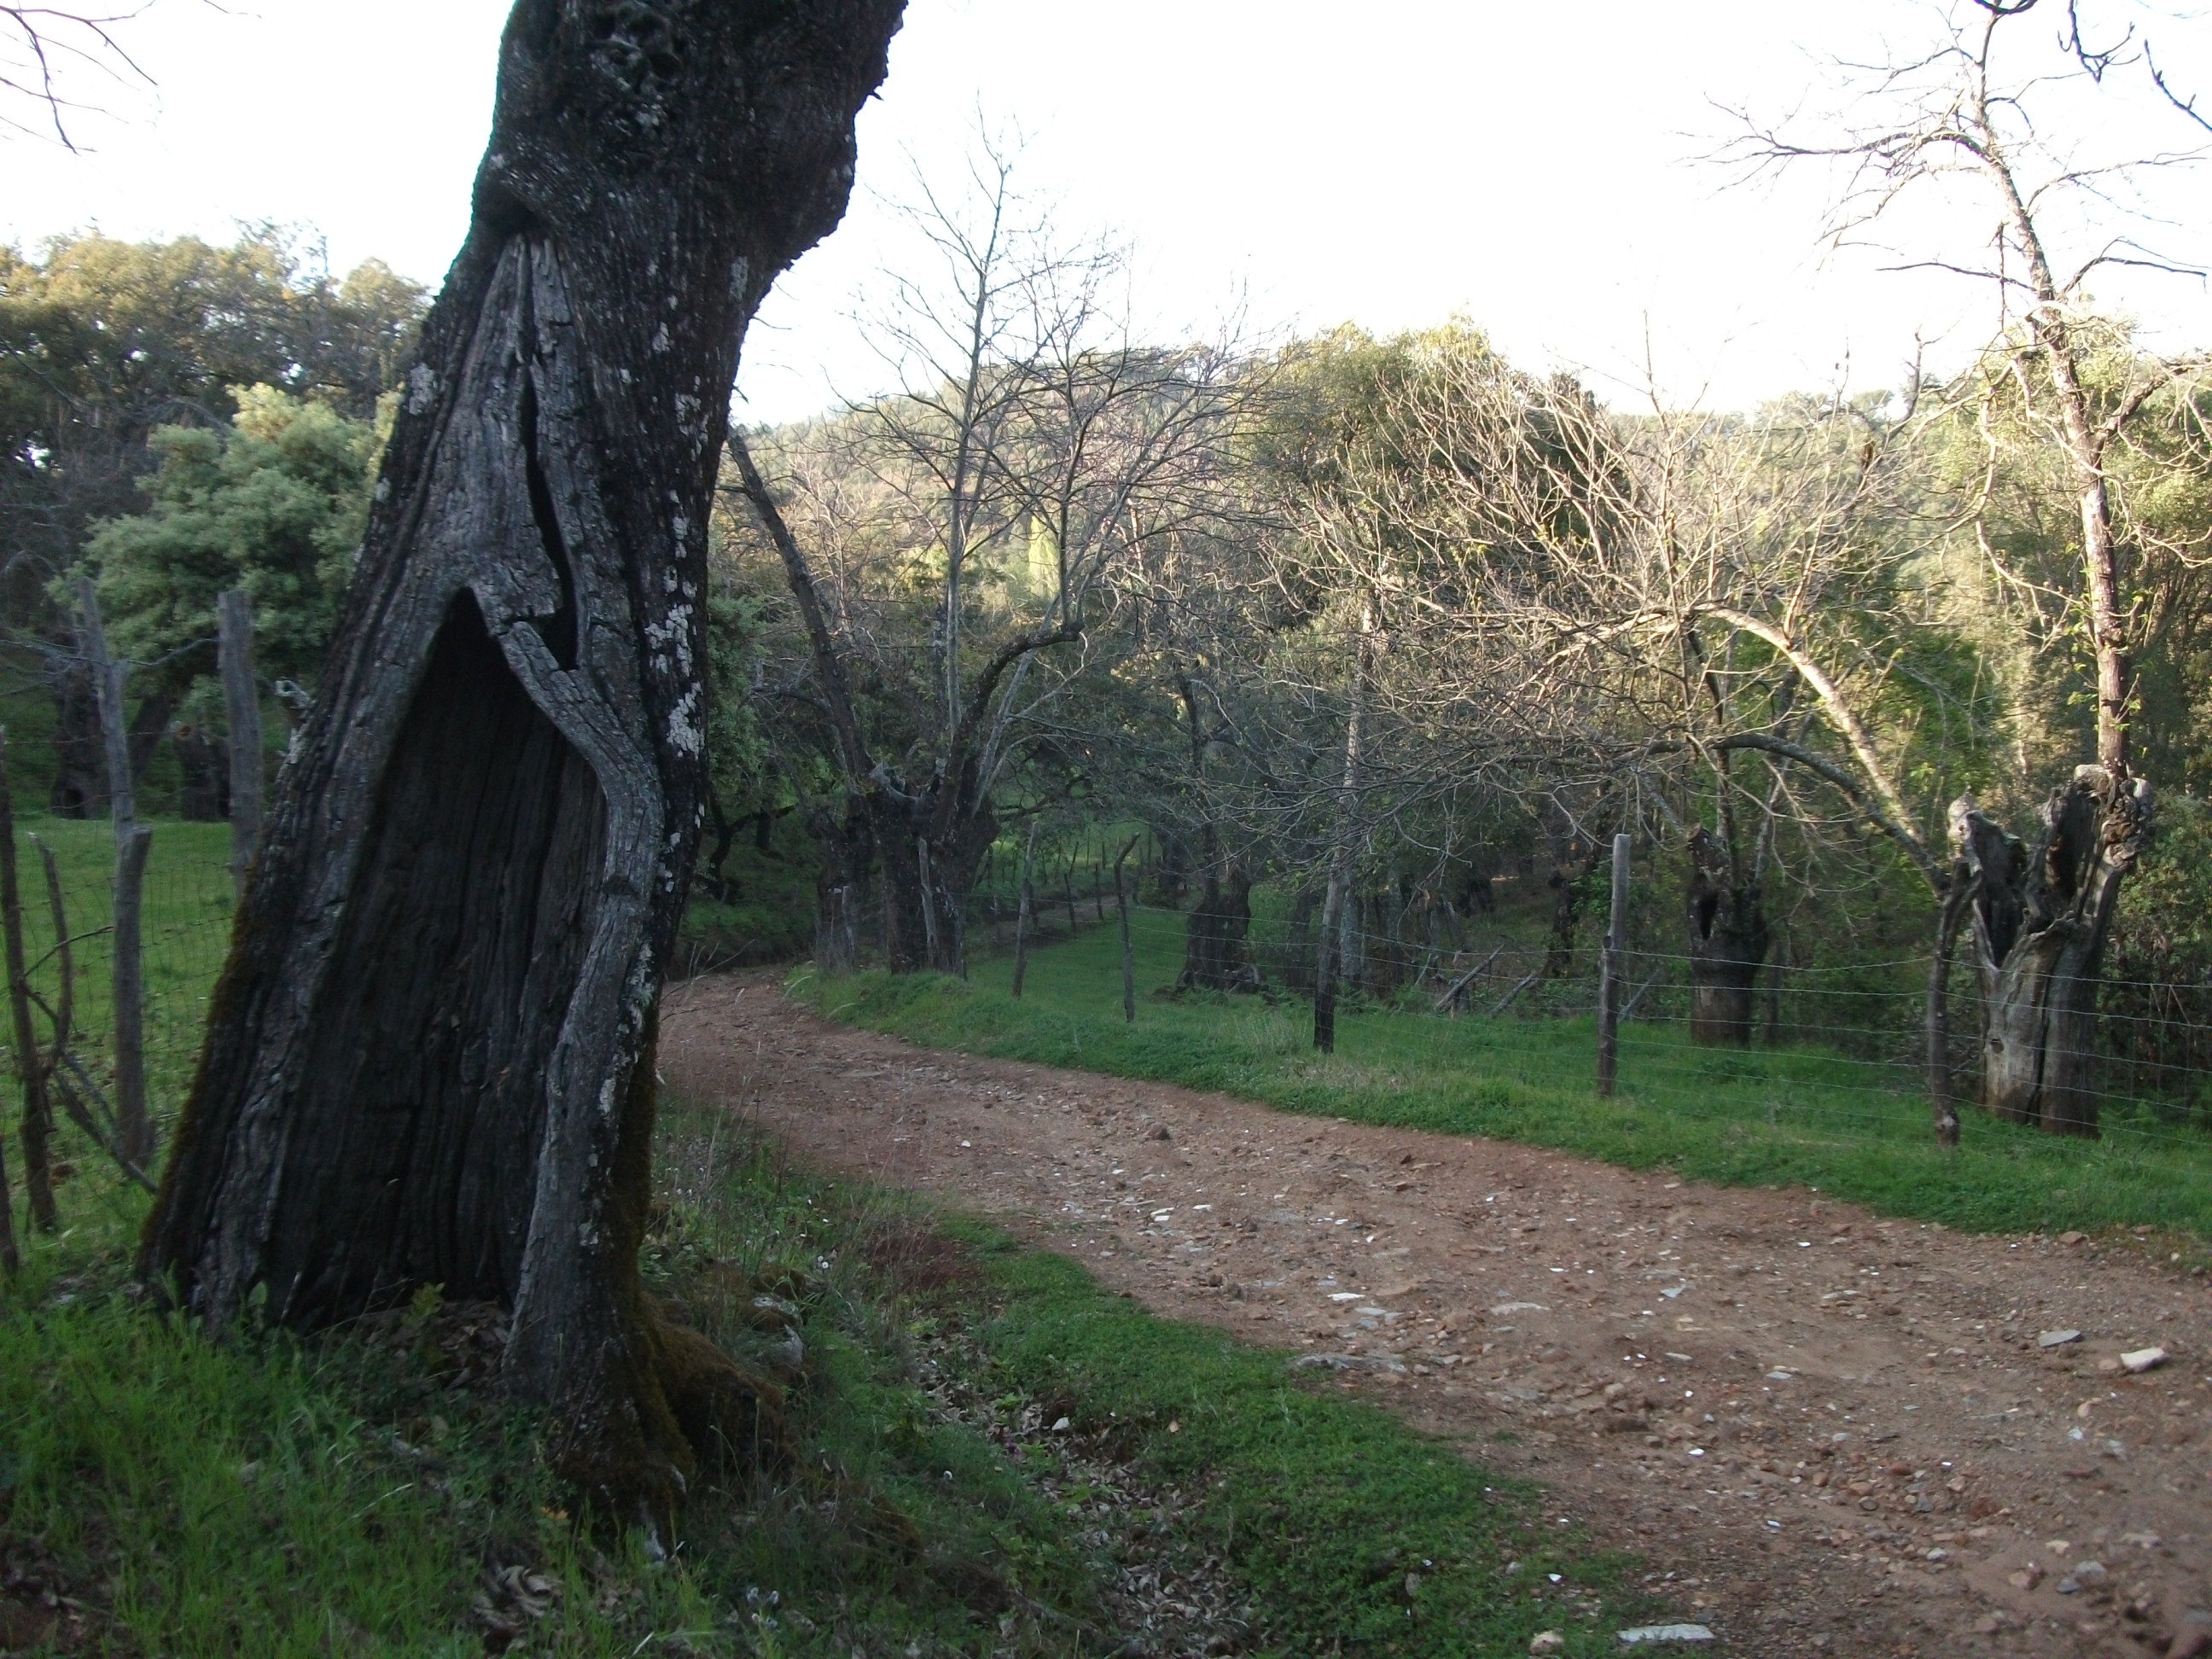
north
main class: Woodland
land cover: Broadleaved woodland
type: broadleaved evergreen forest
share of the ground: 50 - 75 %
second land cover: Grassland without tree/shrub cover
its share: > 75 %
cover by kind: broadleaved forest trees 70 %, herbaceous plants 30 %
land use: Forestry
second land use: Agriculture (excluding fallow land and kitchen gardens)
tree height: > 5 m
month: April
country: ES
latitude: 37.8619
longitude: -6.7207
